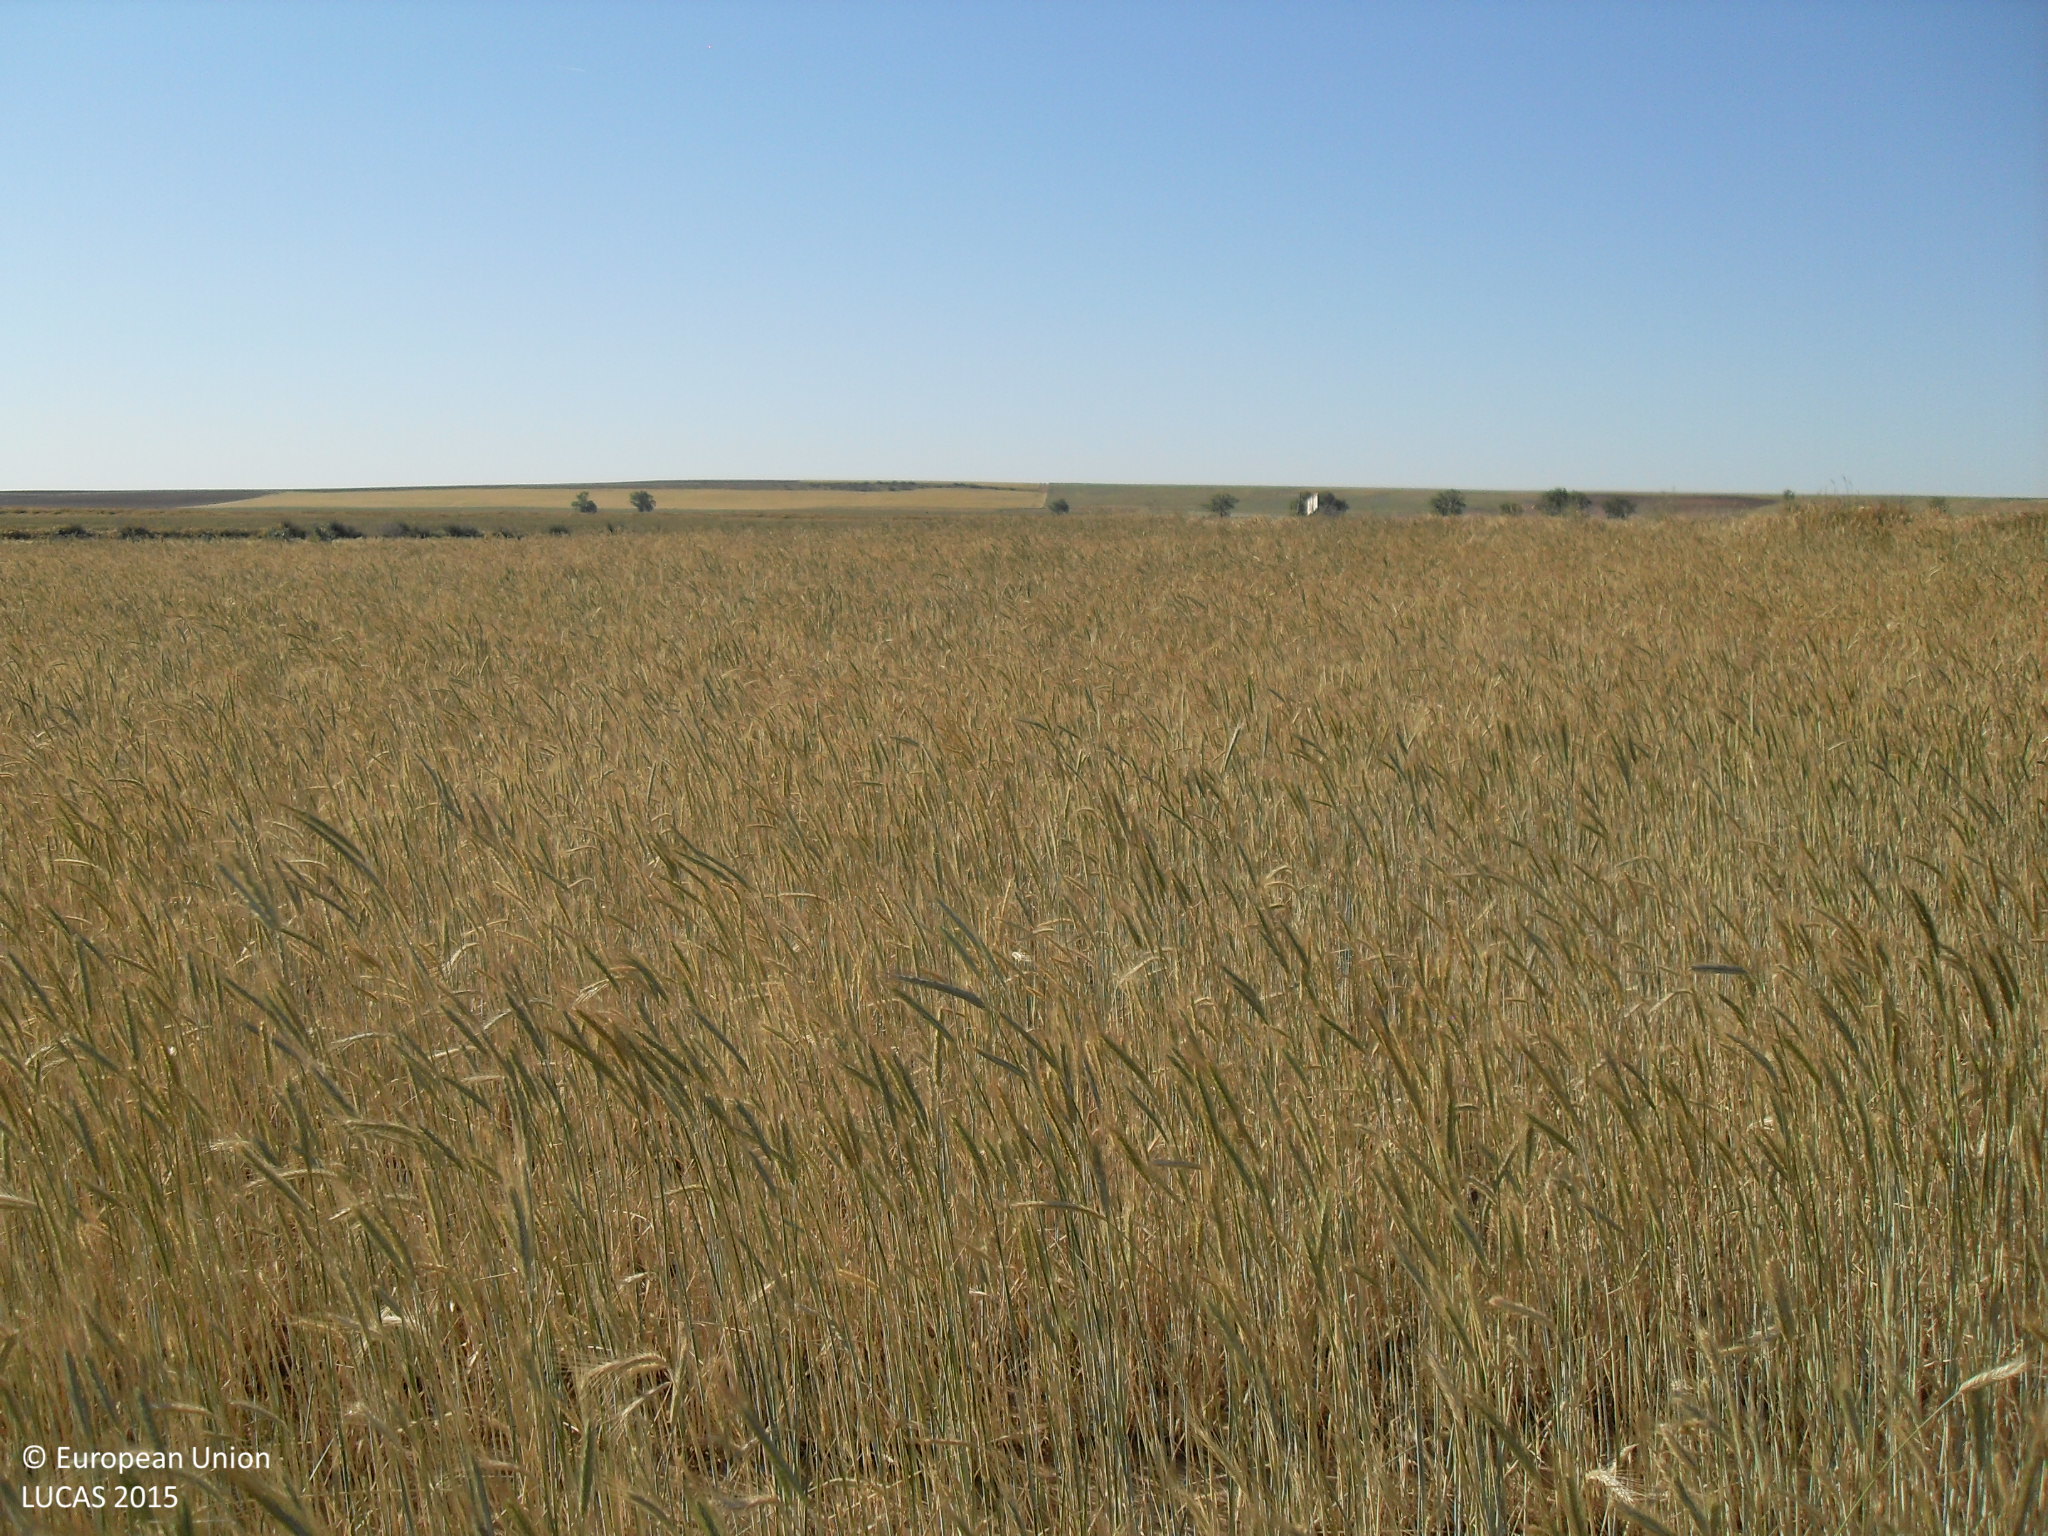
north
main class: Cropland
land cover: Rye
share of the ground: > 75 %
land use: Agriculture (excluding fallow land and kitchen gardens)
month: May
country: ES
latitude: 41.0842
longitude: -5.2724
